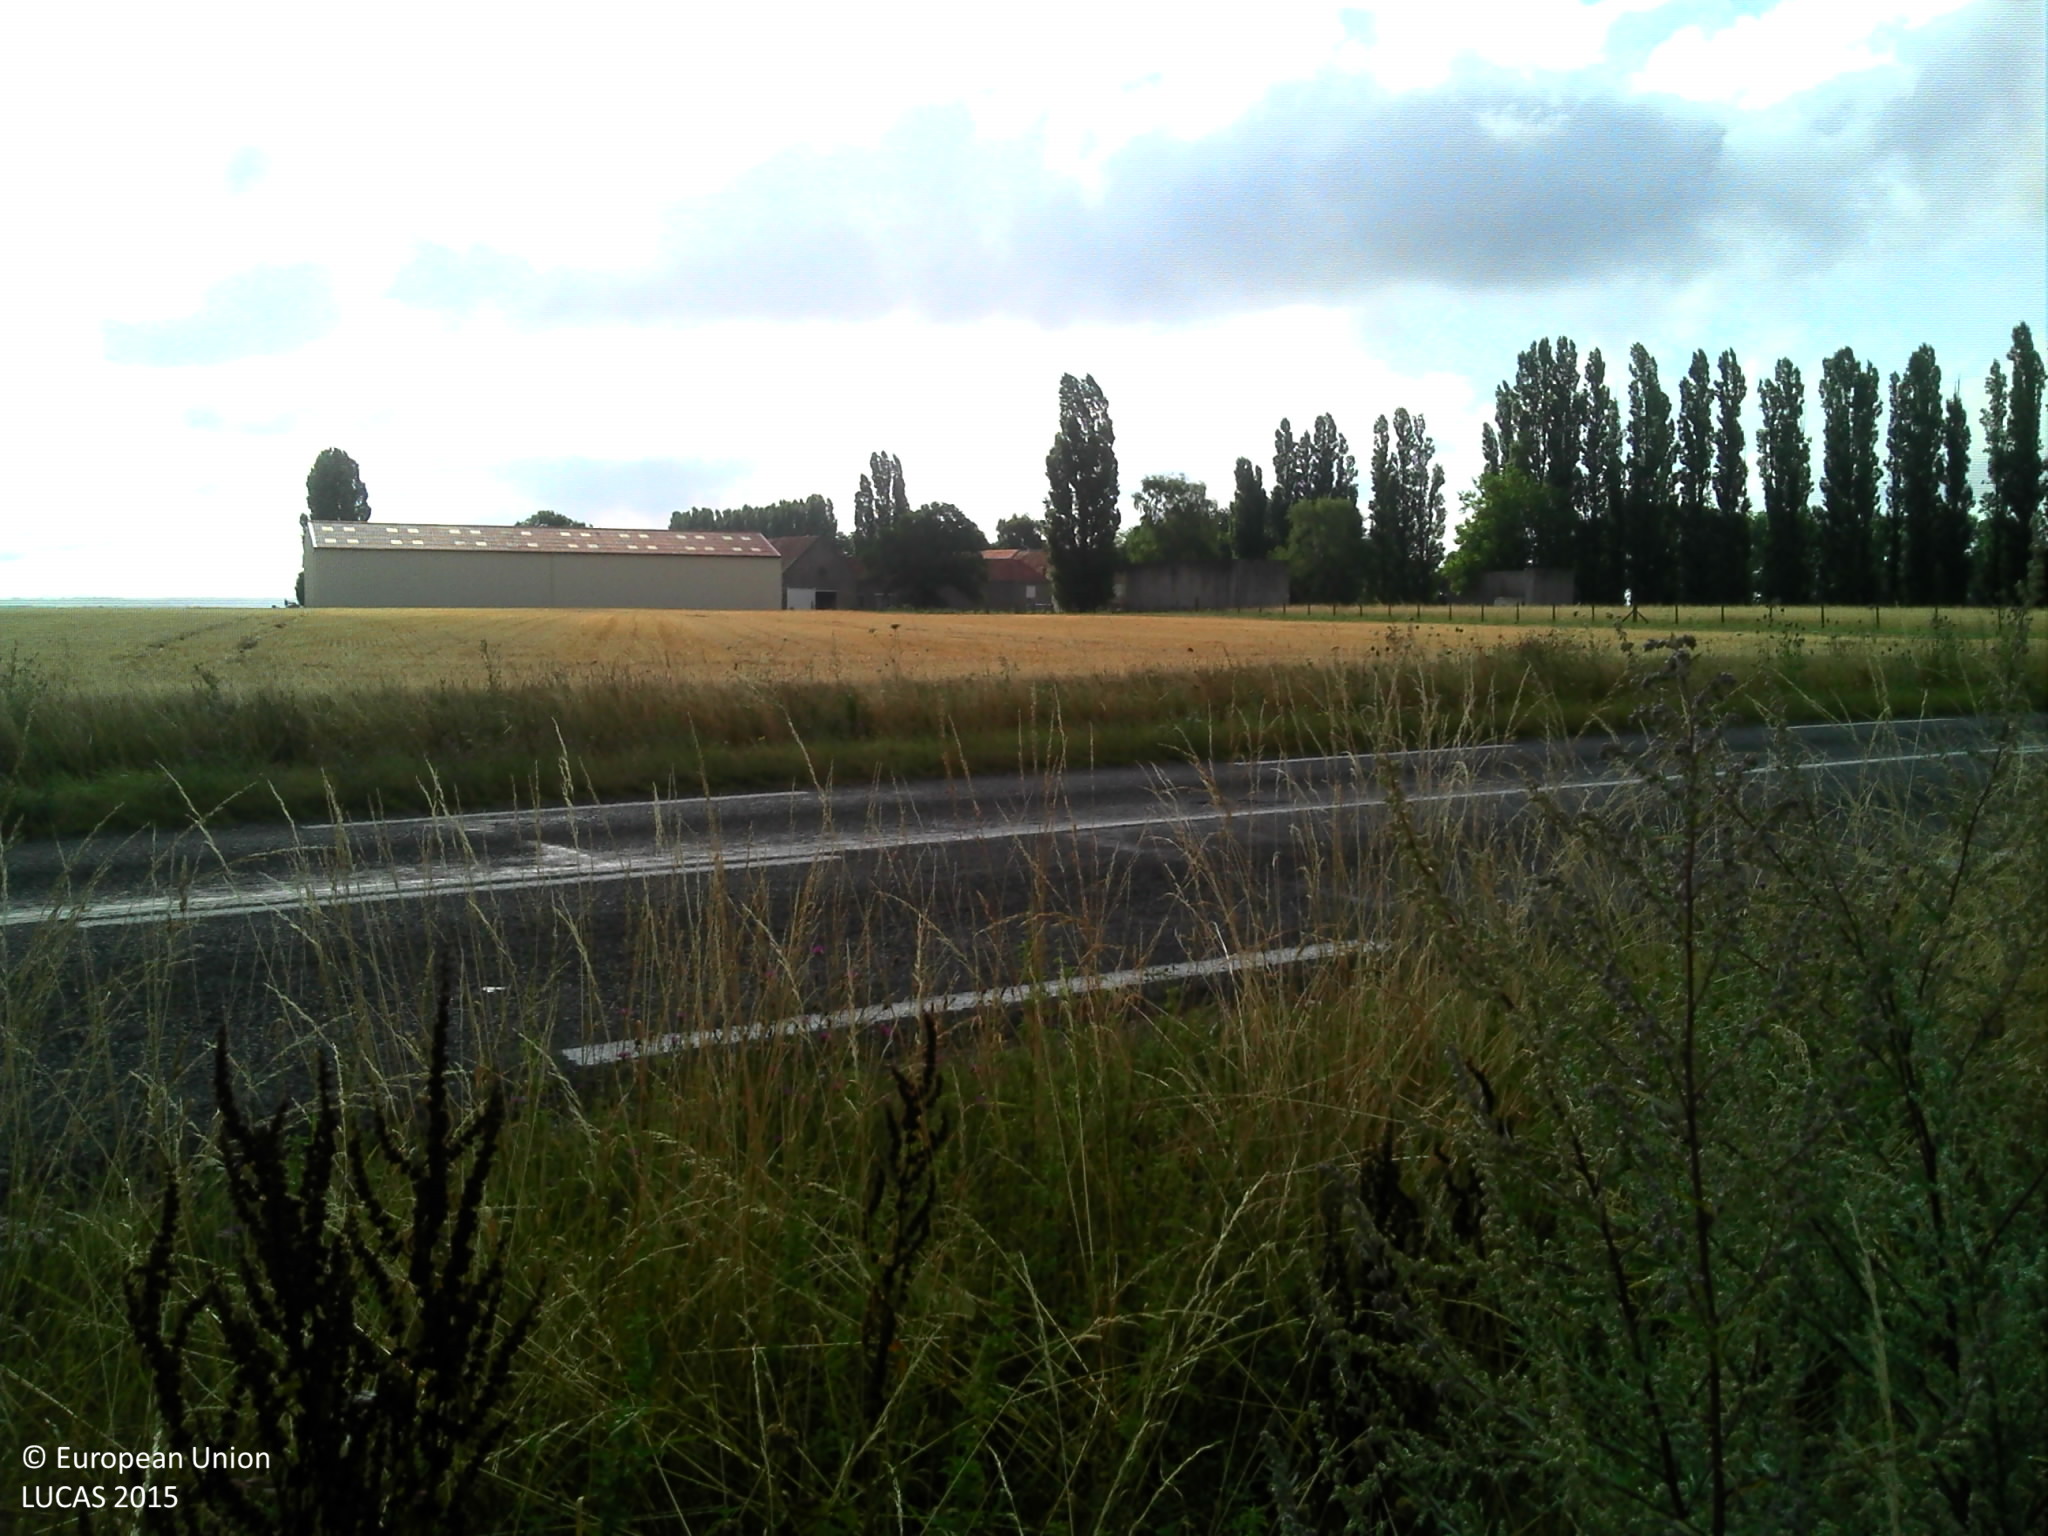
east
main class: Cropland
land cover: Maize
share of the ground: > 75 %
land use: Agriculture (excluding fallow land and kitchen gardens)
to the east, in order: Maize; Ditches and canals; Grass margins; Paved roads, cycling and walking lanes; Grass margins; Ditches and canals; Grass margins; Tracks; Grass margins; Common wheat
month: July
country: FR
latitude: 48.5957
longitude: 2.9815
